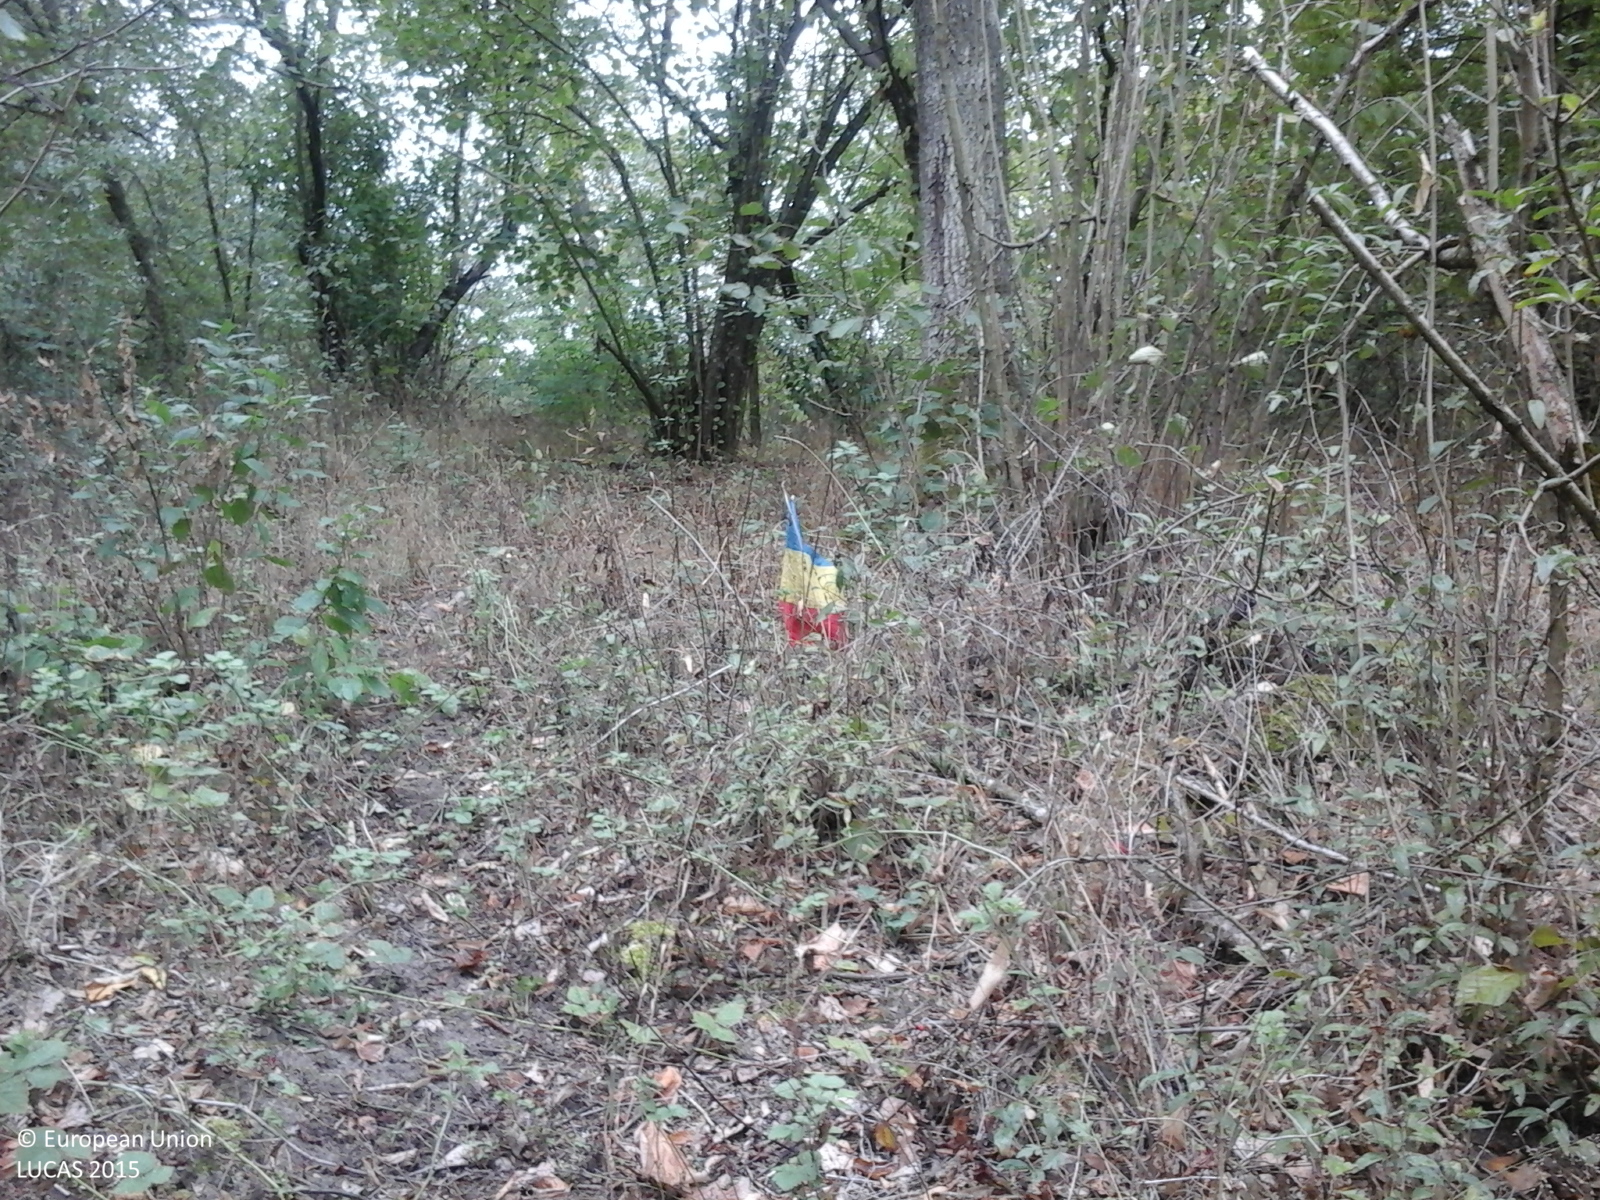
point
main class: Woodland
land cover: Broadleaved woodland
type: mesophytic deciduous forest
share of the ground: > 75 %
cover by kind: broadleaved forest trees 100 %
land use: Forestry
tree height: > 5 m
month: September
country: RO
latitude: 47.7279
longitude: 22.3352
